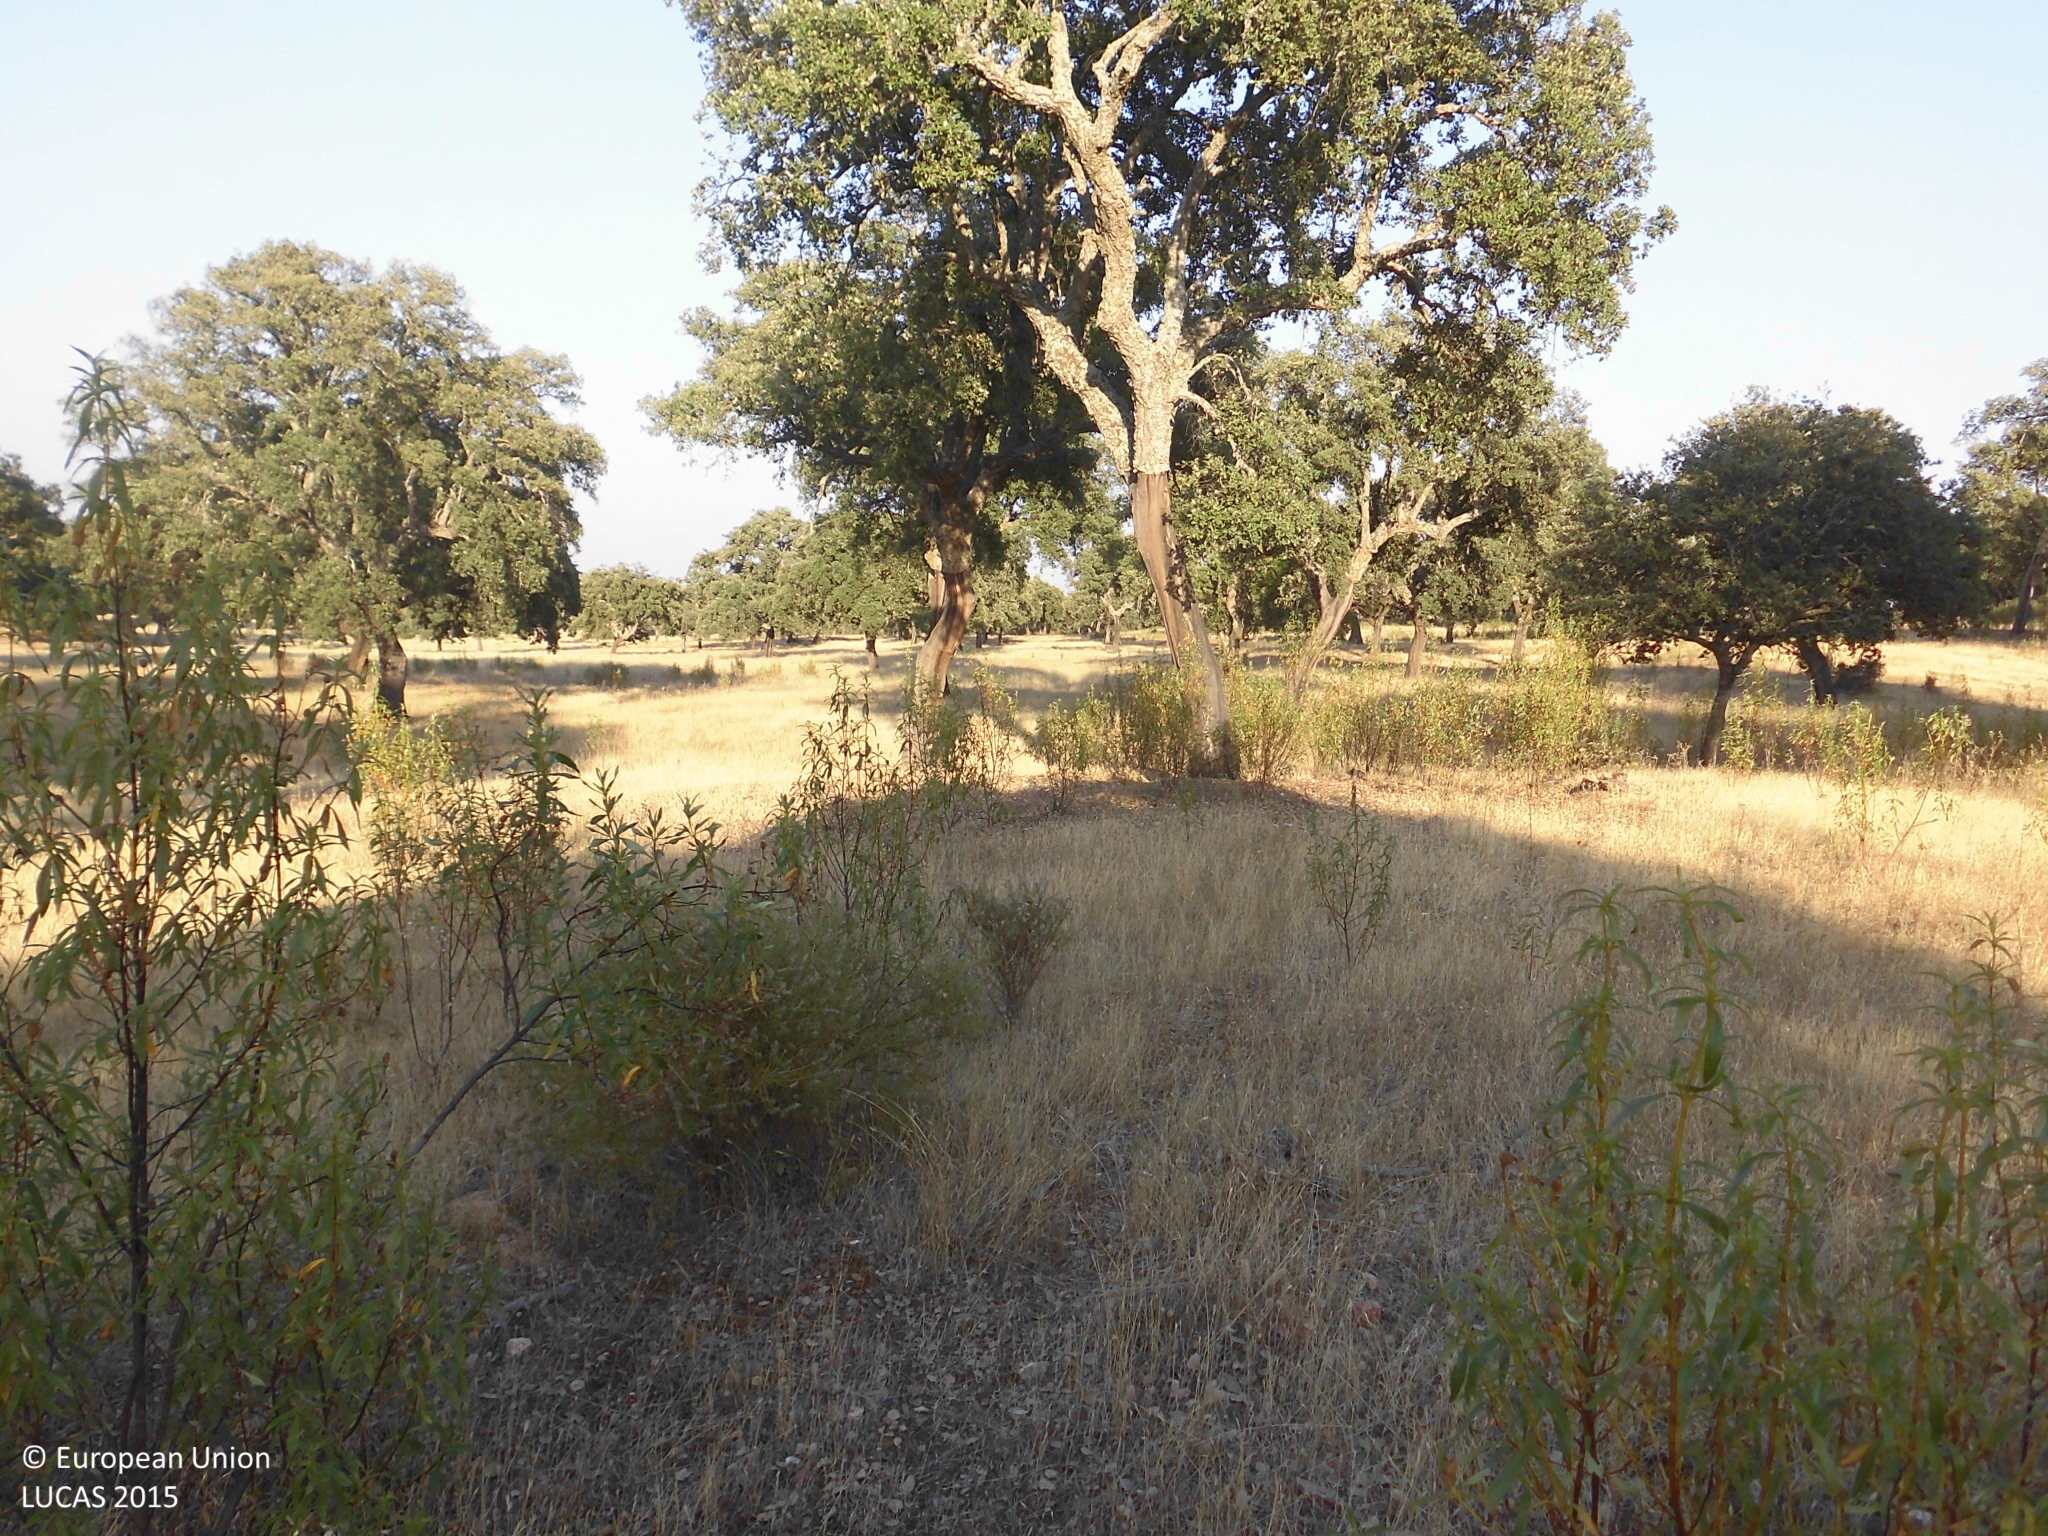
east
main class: Woodland
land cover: Broadleaved woodland
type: broadleaved evergreen forest
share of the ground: 10 - 25 %
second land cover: Grassland without tree/shrub cover
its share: > 75 %
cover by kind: herbaceous plants 60 %, broadleaved forest trees 30 %, shrubs 10 %
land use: Forestry
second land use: Agriculture (excluding fallow land and kitchen gardens)
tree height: > 5 m
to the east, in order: Broadleaved woodland; Grassland without tree/shrub cover; Broadleaved woodland; Grassland with sparse tree/shrub cover
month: June
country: ES
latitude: 39.9213
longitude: -5.9913
